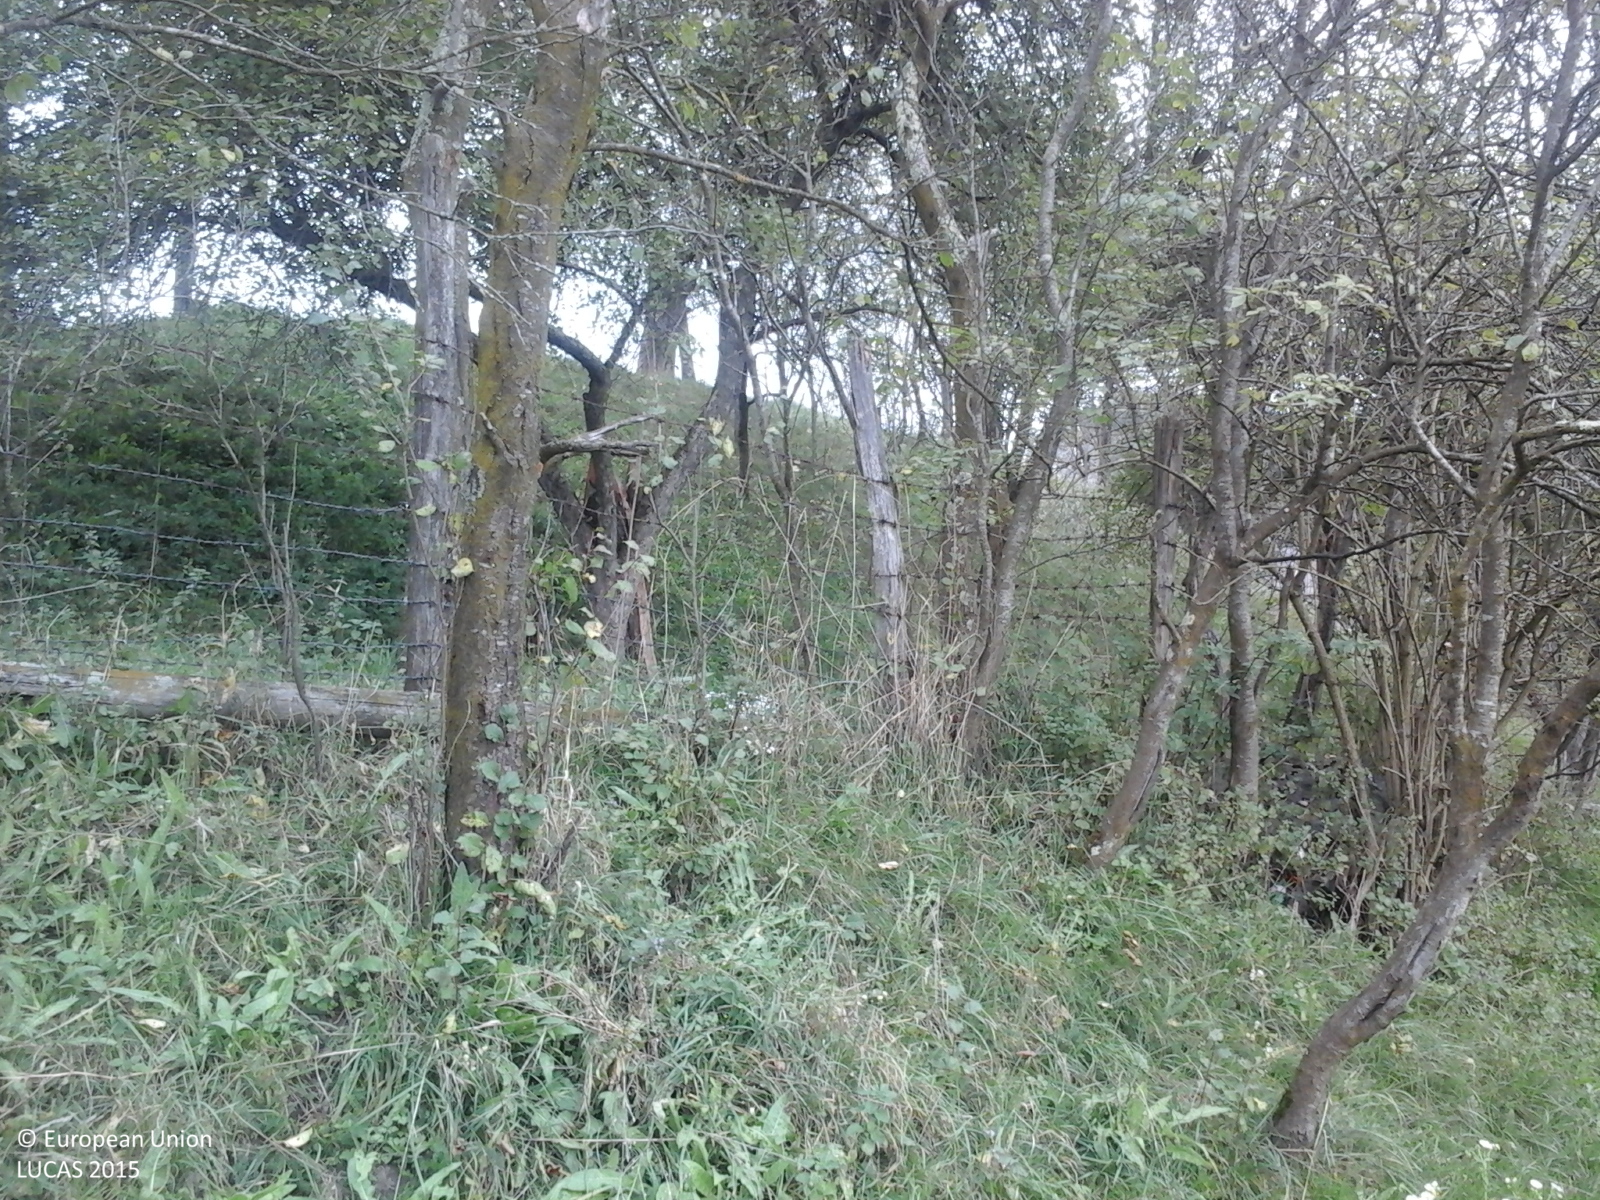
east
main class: Cropland
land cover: Apple fruit
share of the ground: 50 - 75 %
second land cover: Grassland without tree/shrub cover
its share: > 75 %
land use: Agriculture (excluding fallow land and kitchen gardens)
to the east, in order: Apple fruit; Grassland without tree/shrub cover; Fences; Maize; Artificial constructions in urban areas; Broadleaved woodland; Rivers and streams; Broadleaved woodland; Arable land (only in case pi); Broadleaved woodland; Artificial constructions in urban areas
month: October
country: RO
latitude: 46.3675
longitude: 23.2035
